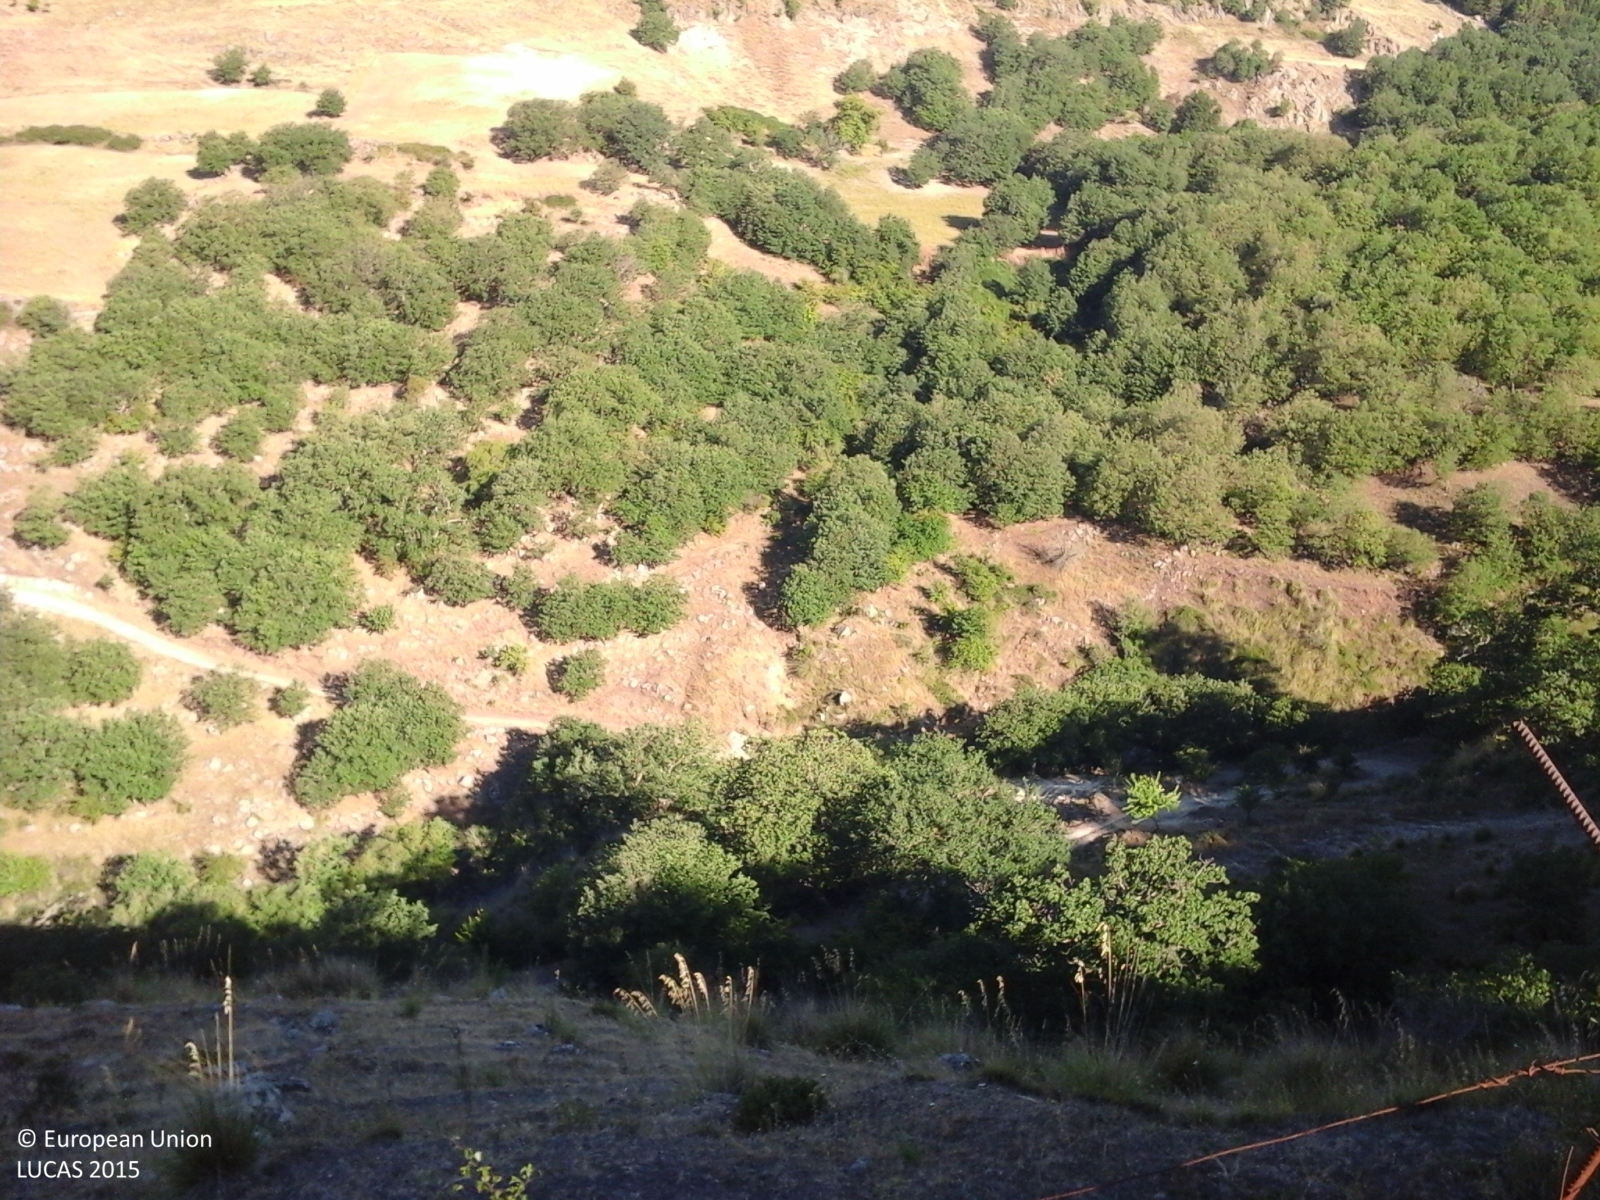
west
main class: Woodland
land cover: Broadleaved woodland
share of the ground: > 75 %
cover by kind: herbaceous plants 75 %, broadleaved forest trees 20 %, consolidated bare surface 5 %
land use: Semi-natural and natural areas not in use
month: July
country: IT
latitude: 37.0801
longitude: 14.8110
